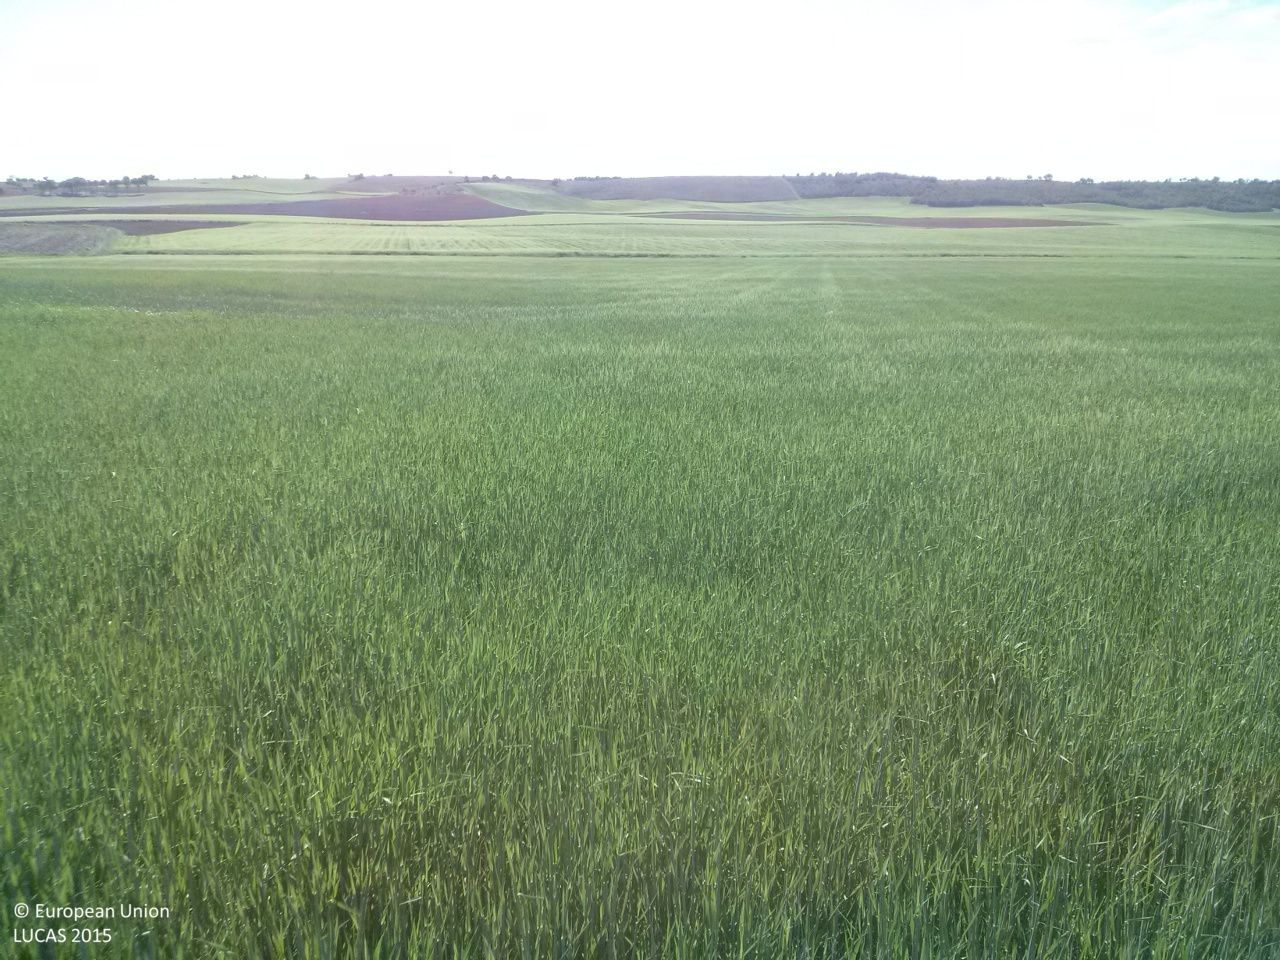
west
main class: Cropland
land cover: Barley
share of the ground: > 75 %
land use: Agriculture (excluding fallow land and kitchen gardens)
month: May
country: ES
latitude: 39.7994
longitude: -2.7369
